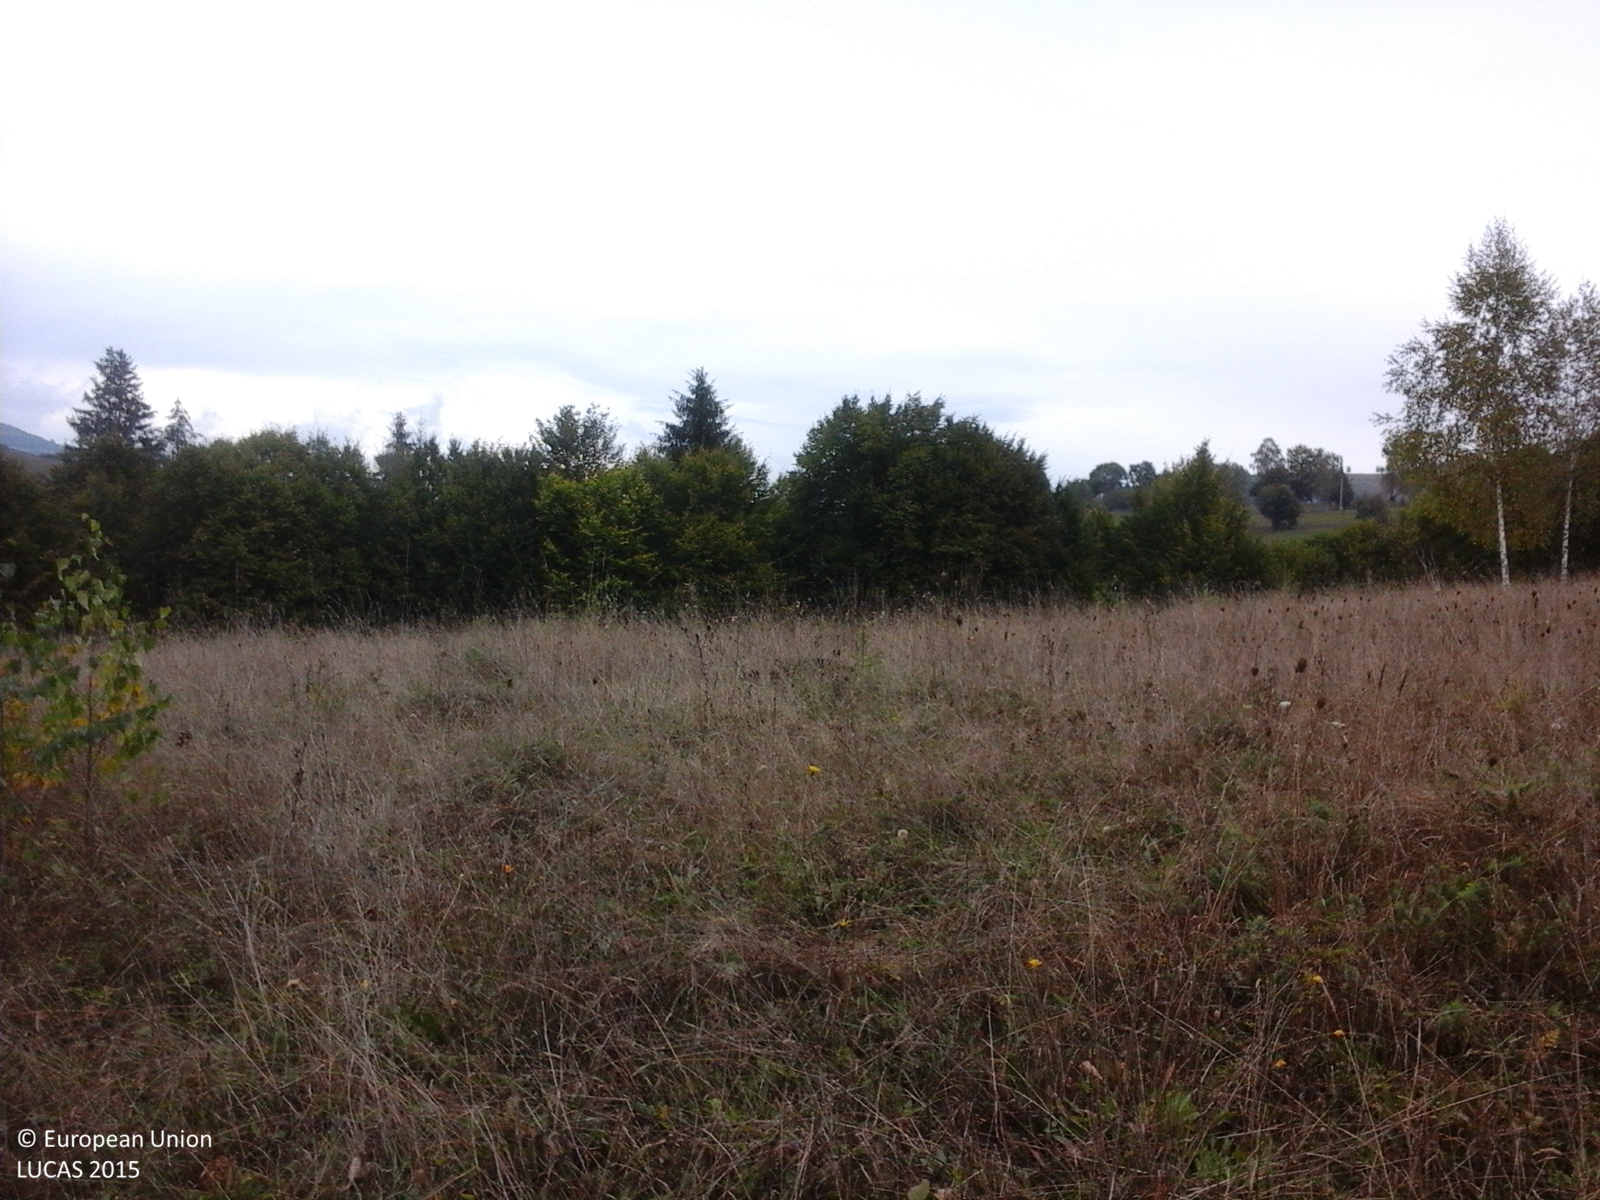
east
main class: Grassland
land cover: Grassland with sparse tree/shrub cover
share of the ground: > 75 %
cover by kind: herbaceous plants 85 %, shrubs 10 %, broadleaved forest trees 5 %
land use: Agriculture (excluding fallow land and kitchen gardens)
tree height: > 5 m
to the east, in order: Grassland with sparse tree/shrub cover; Grassland without tree/shrub cover; Lines of trees; Tracks; Grassland without tree/shrub cover; Broadleaved woodland; Grassland without tree/shrub cover; Abandoned hedges; Grassland with sparse tree/shrub cover; Broadleaved woodland; Grassland without tree/shrub cover
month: October
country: RO
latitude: 46.3593
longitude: 23.1222
